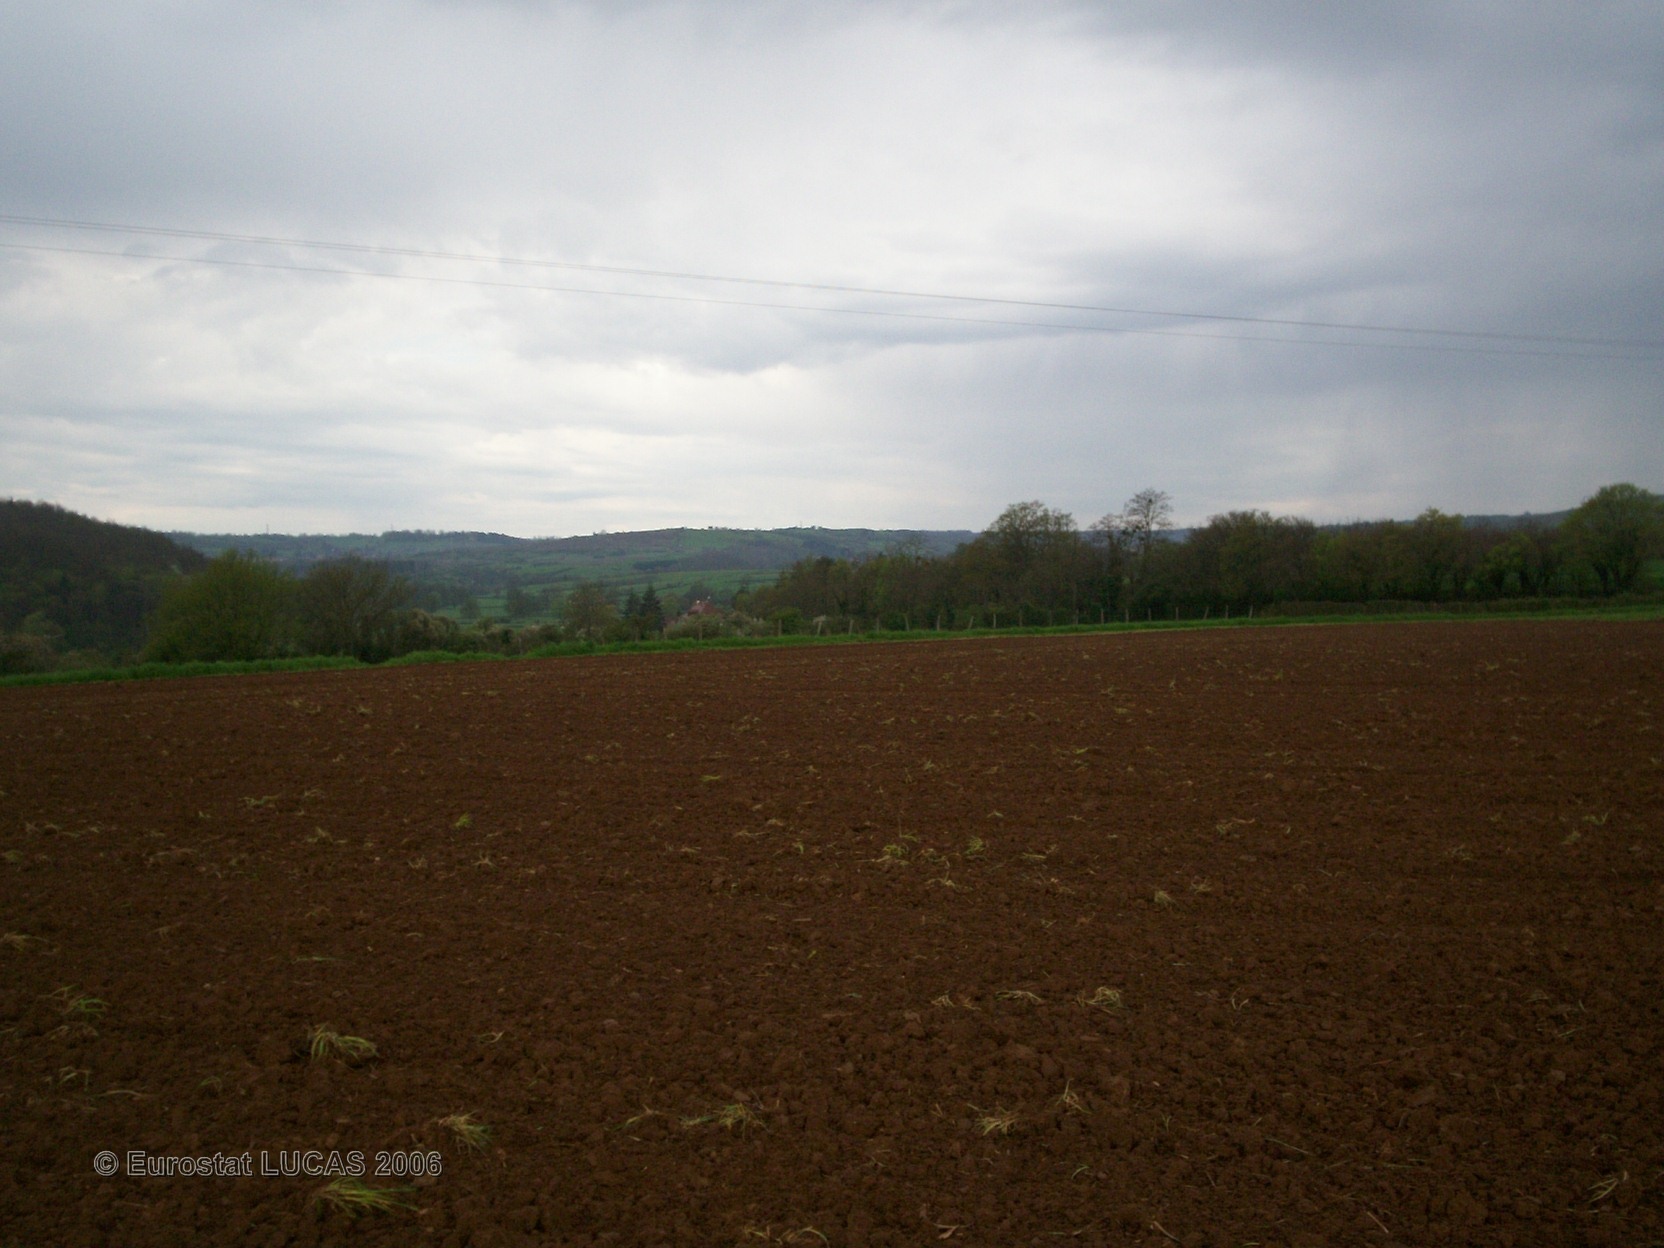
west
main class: Cropland
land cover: Sunflower
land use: Agriculture (excluding fallow land and kitchen gardens)
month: May
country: FR
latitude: 46.8663
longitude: 4.6353
